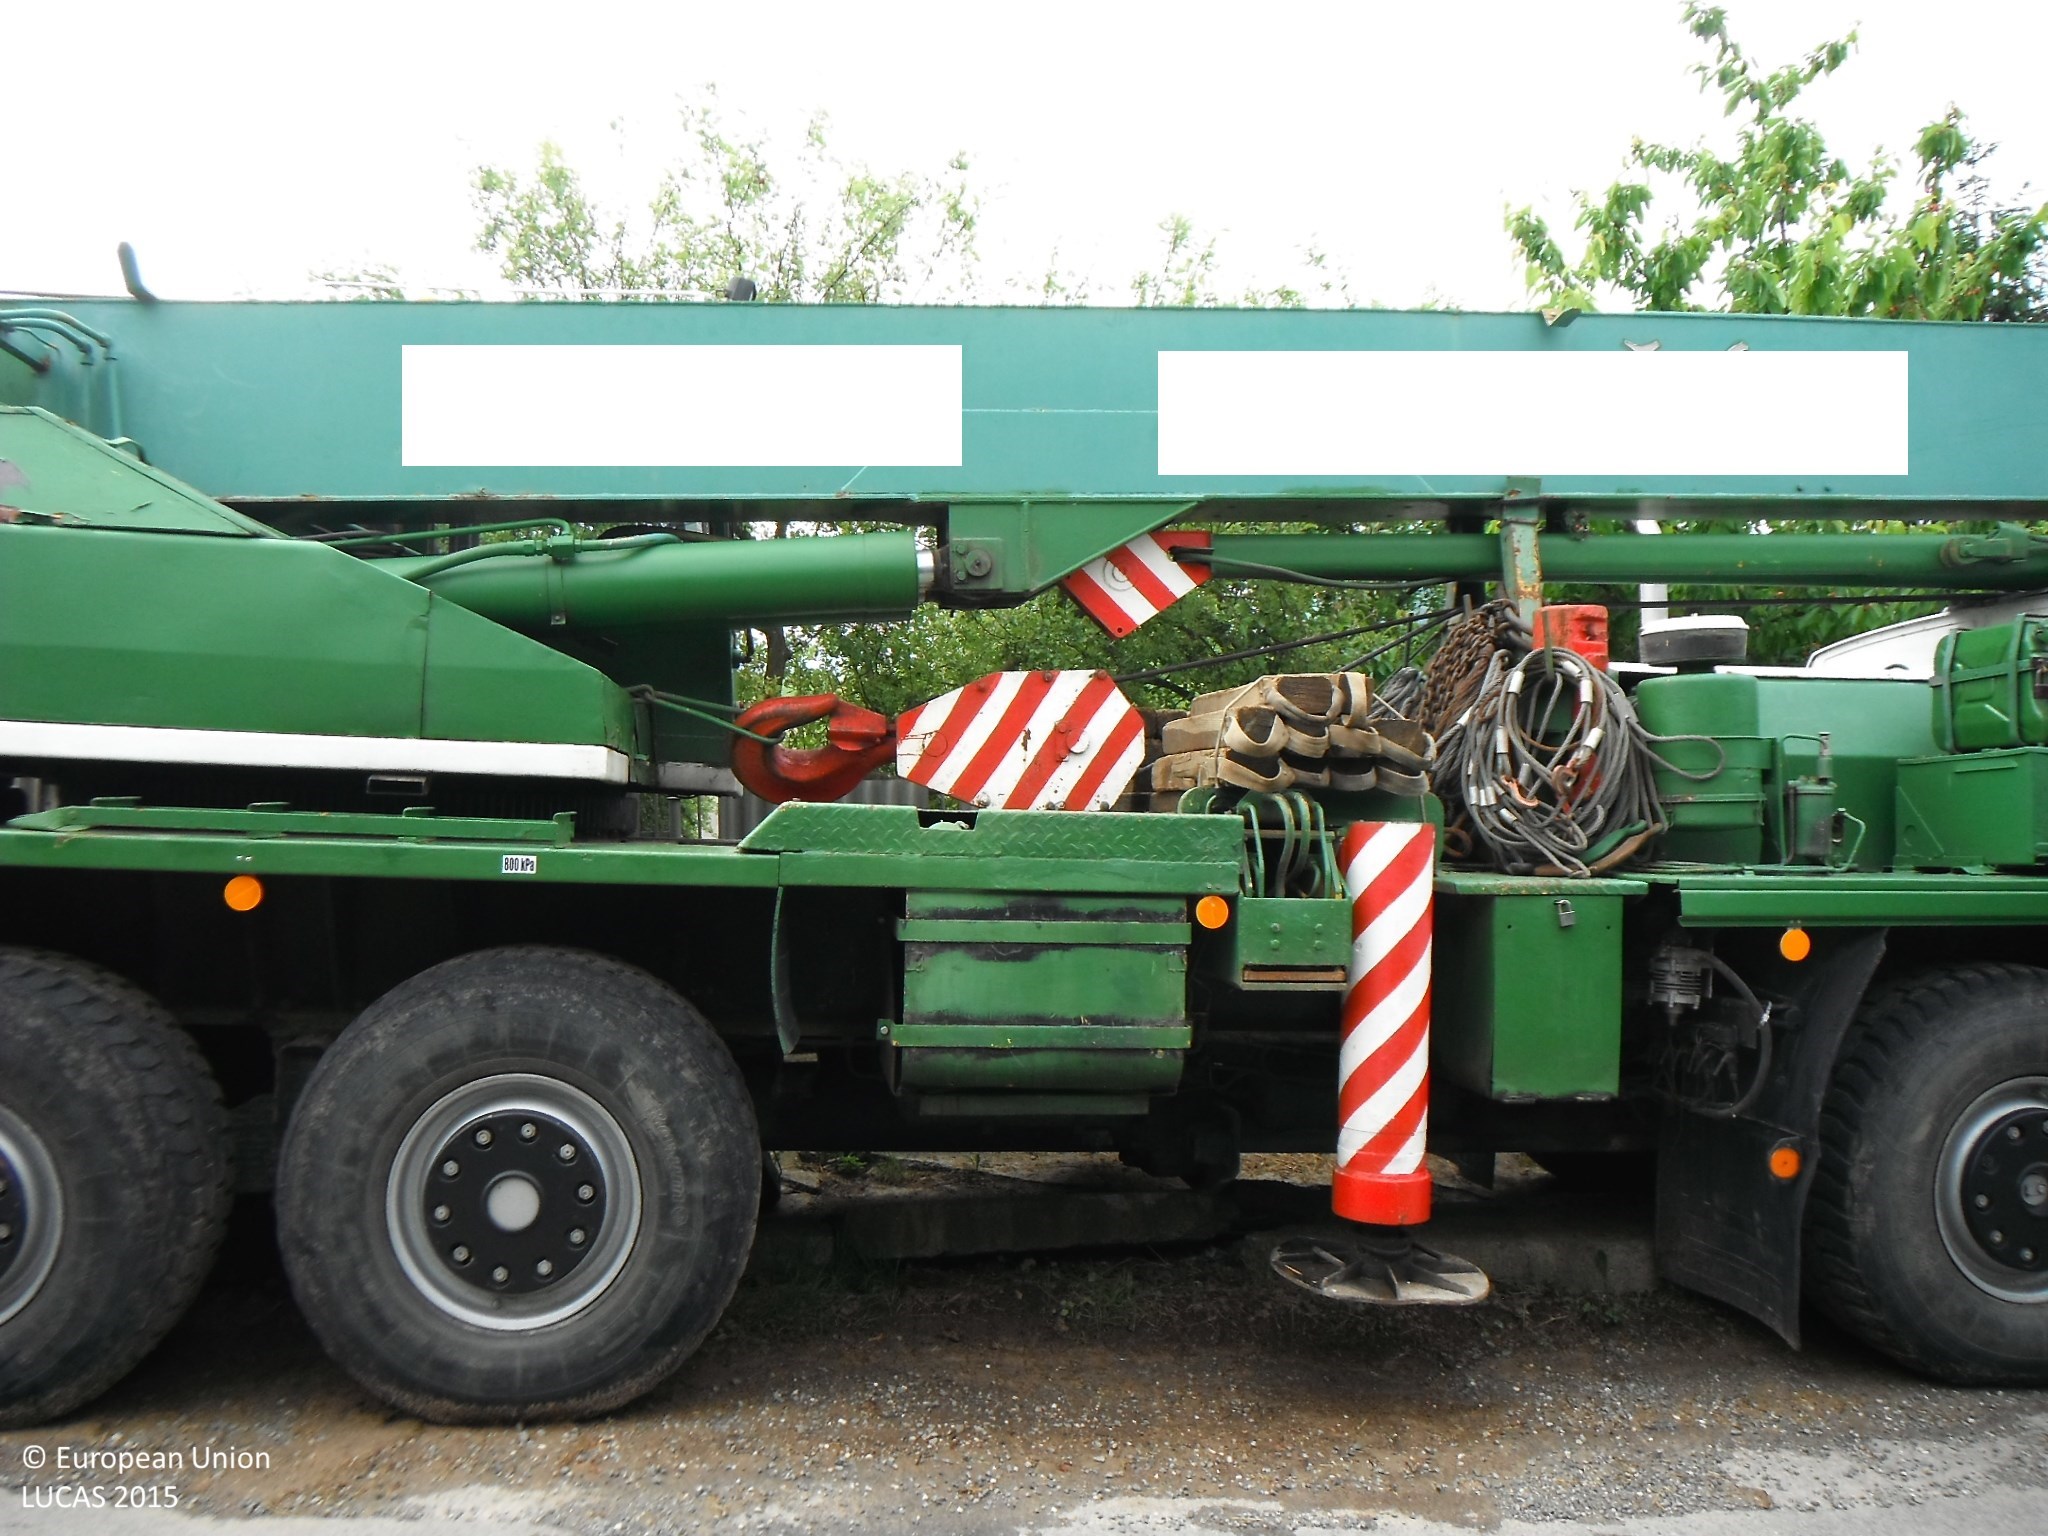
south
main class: Cropland
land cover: Apple fruit
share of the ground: 50 - 75 %
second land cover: Grassland without tree/shrub cover
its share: > 75 %
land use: Kitchen garden
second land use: Residential
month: June
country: SK
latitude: 49.0921
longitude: 21.3165
